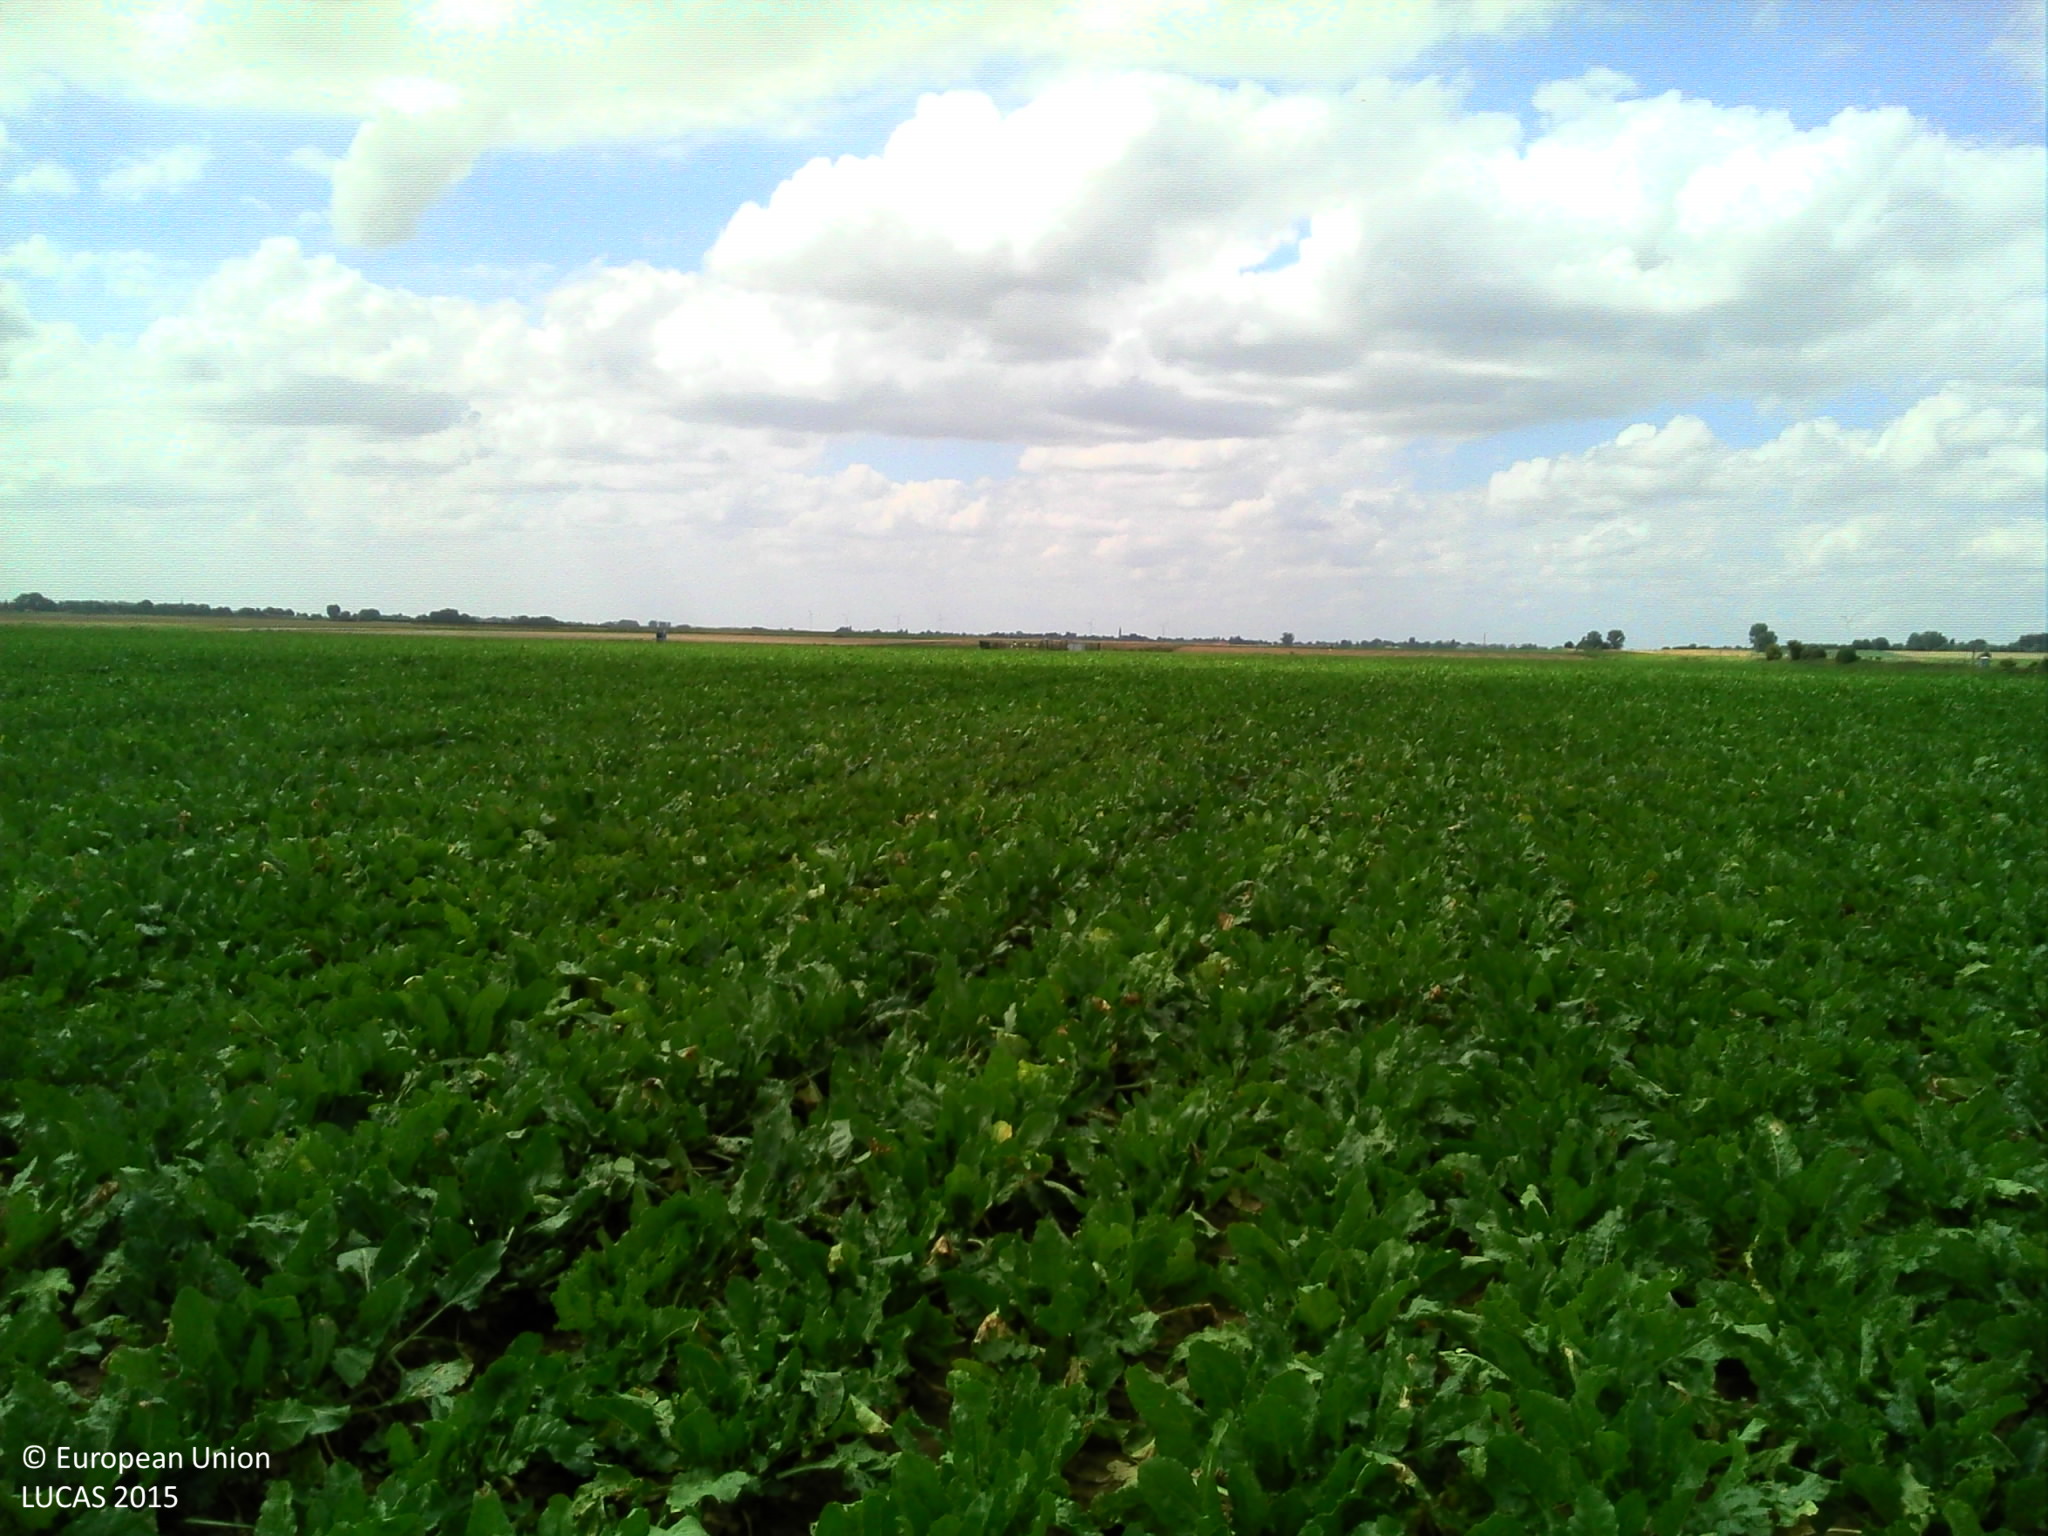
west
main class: Cropland
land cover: Sugar beet
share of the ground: > 75 %
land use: Agriculture (excluding fallow land and kitchen gardens)
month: August
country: FR
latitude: 49.8106
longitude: 2.7770
